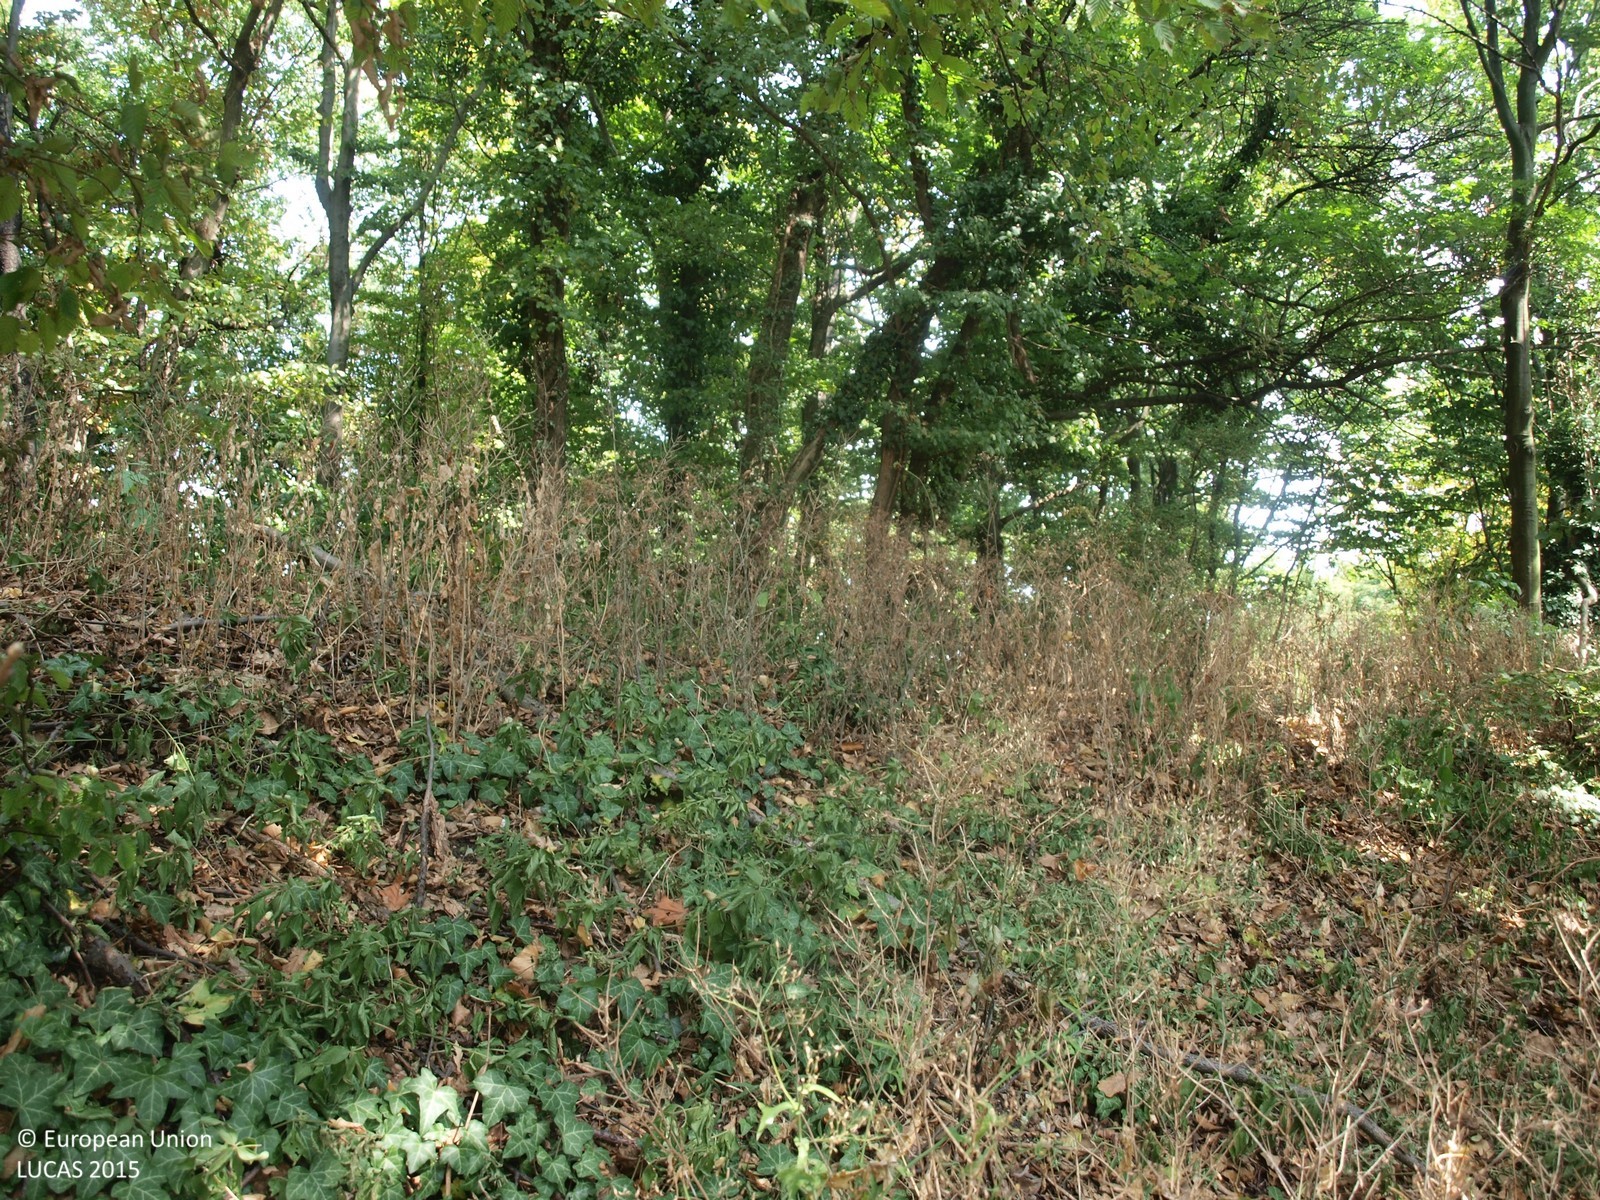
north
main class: Woodland
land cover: Broadleaved woodland
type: mesophytic deciduous forest
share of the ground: > 75 %
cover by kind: broadleaved forest trees 100 %
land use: Forestry
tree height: > 5 m
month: August
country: HR
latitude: 46.1246
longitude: 16.3799
